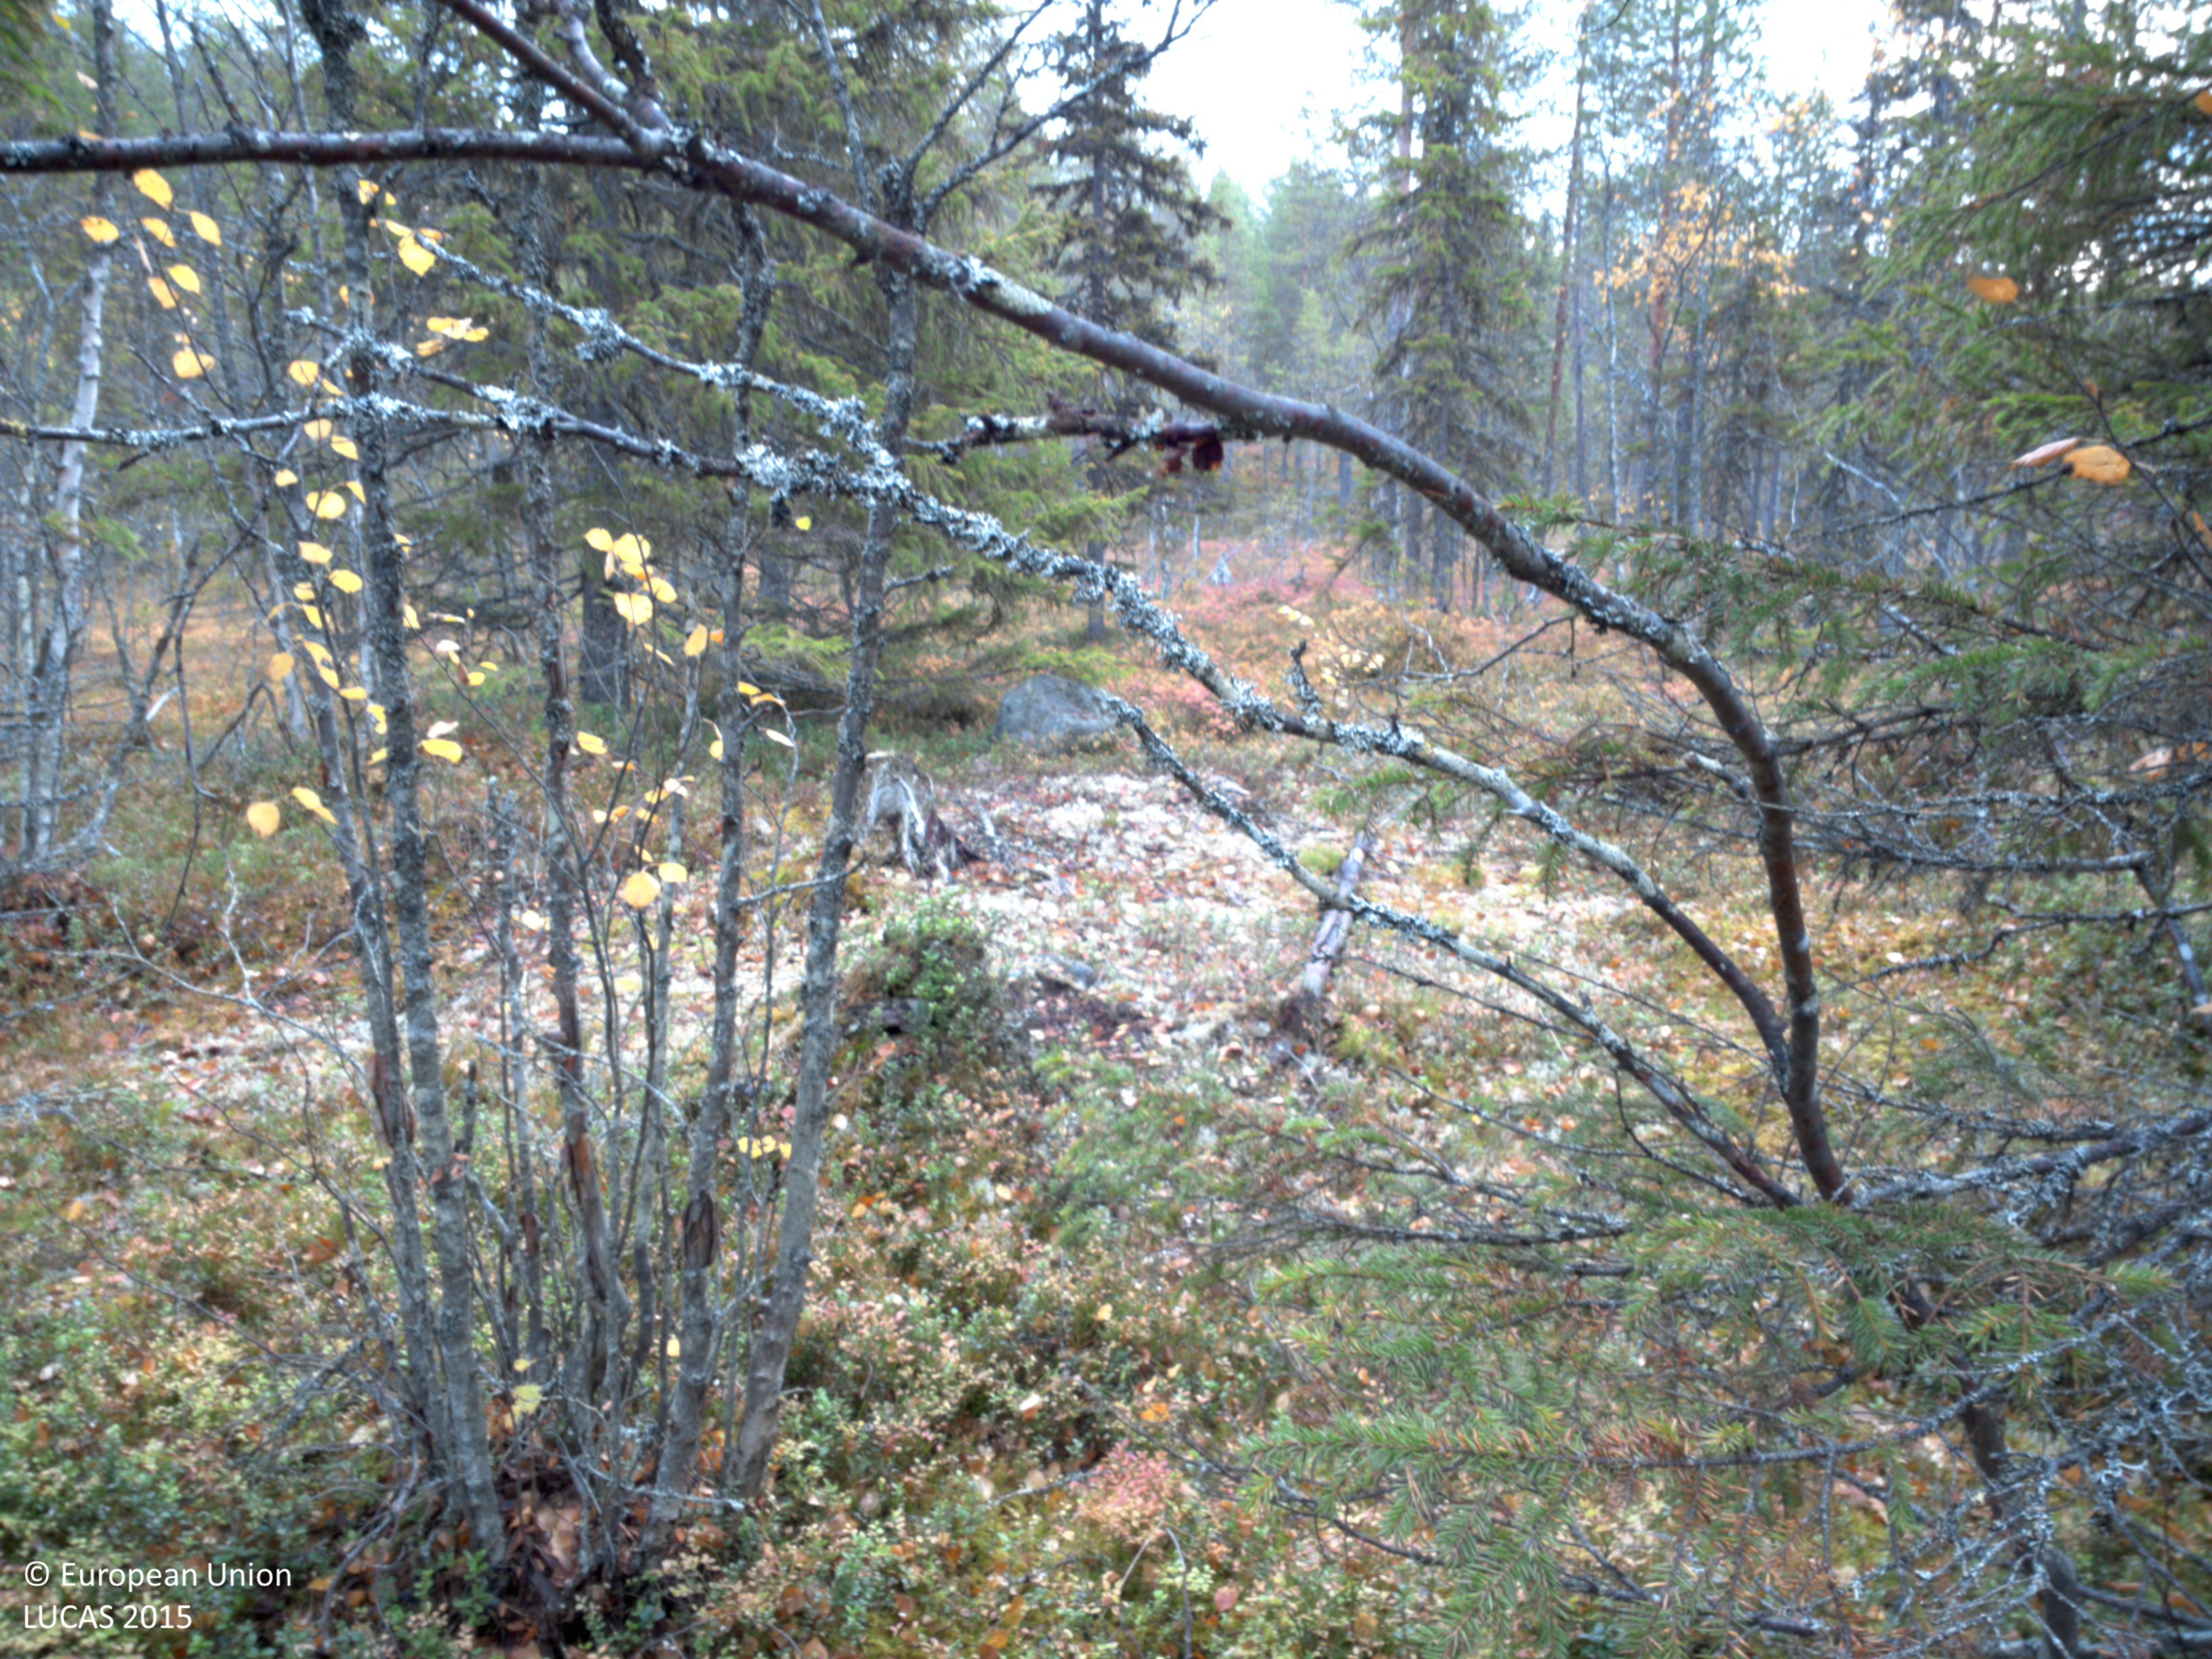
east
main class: Woodland
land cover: Other coniferous woodland
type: boreal forest
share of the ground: 50 - 75 %
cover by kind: coniferous forest trees 65 %, shrubs 20 %, broadleaved forest trees 5 %, herbaceous plants 5 %, lichens and mosses 5 %
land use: Forestry
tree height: > 5 m
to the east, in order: Other coniferous woodland; Pine dominated coniferous woodland; Spruce dominated coniferous woodland; Other coniferous woodland; Pine dominated coniferous woodland
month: October
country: SE
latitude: 64.9819
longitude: 17.9109
